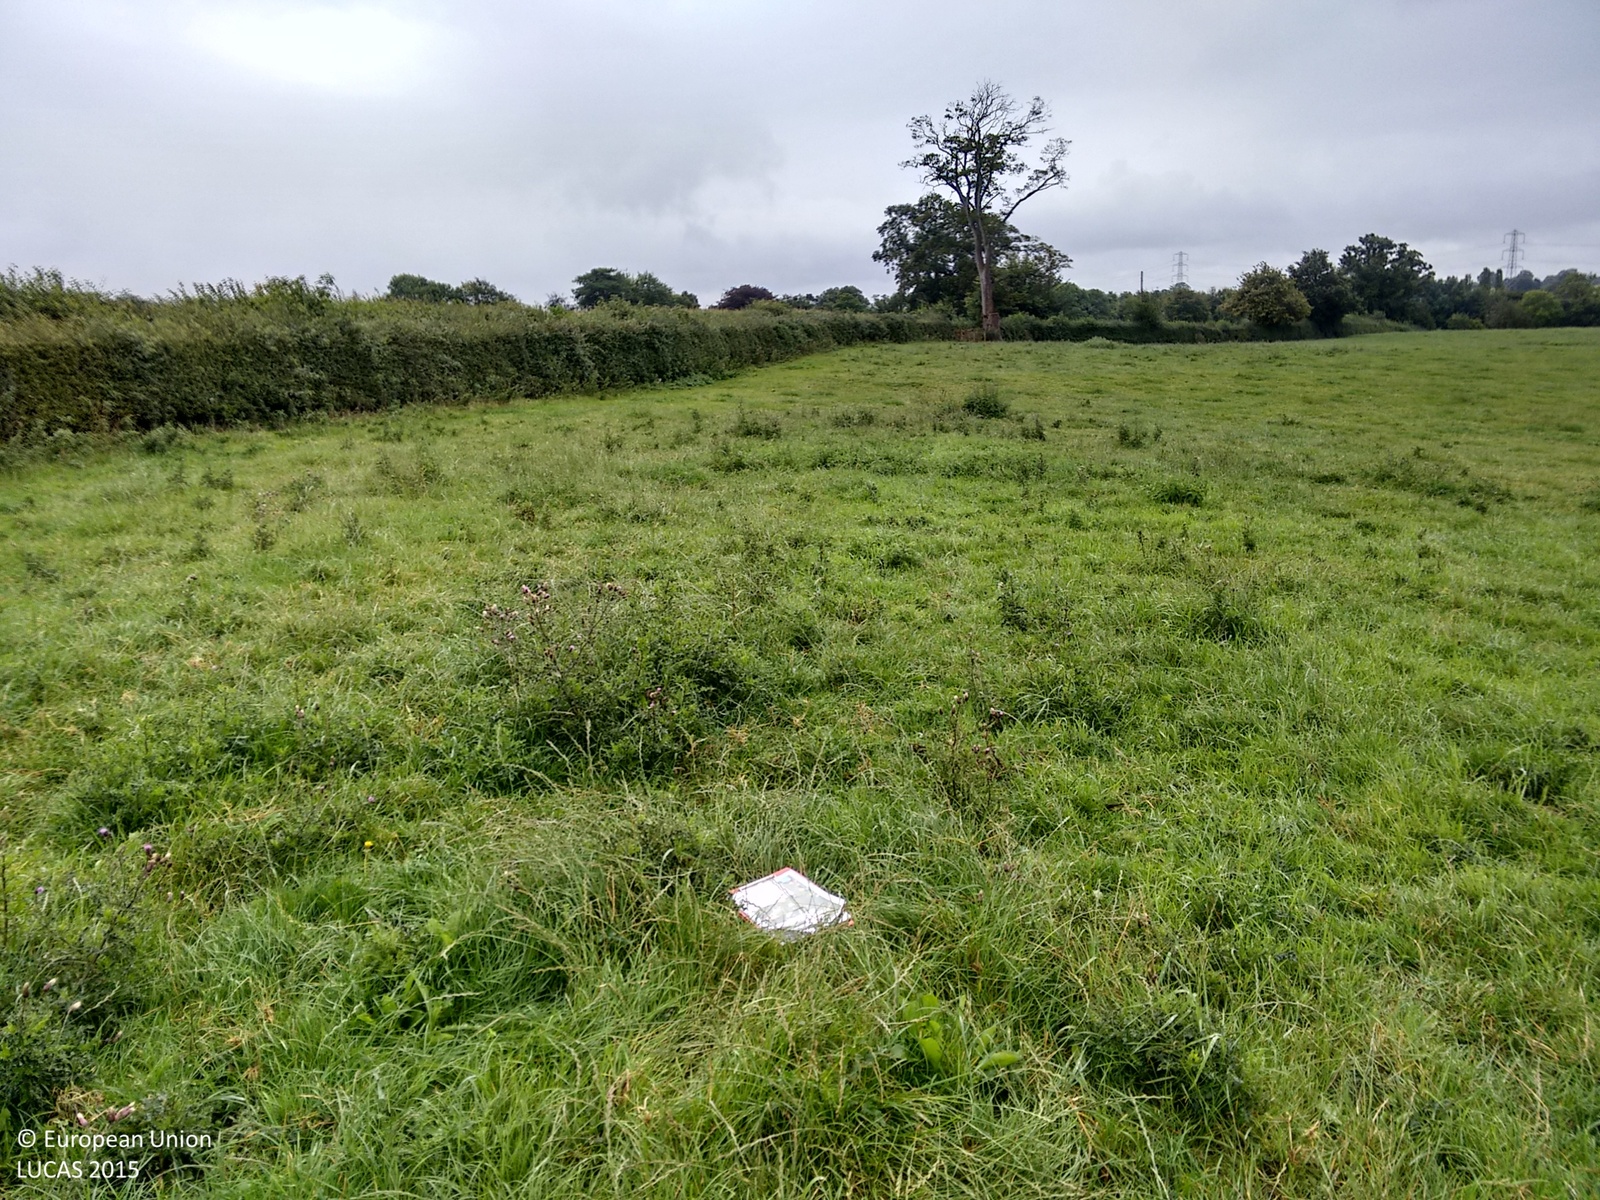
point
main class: Grassland
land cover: Grassland without tree/shrub cover
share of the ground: > 75 %
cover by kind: herbaceous plants 100 %
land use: Agriculture (excluding fallow land and kitchen gardens)
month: September
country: GB
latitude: 52.9370
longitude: -2.9743
